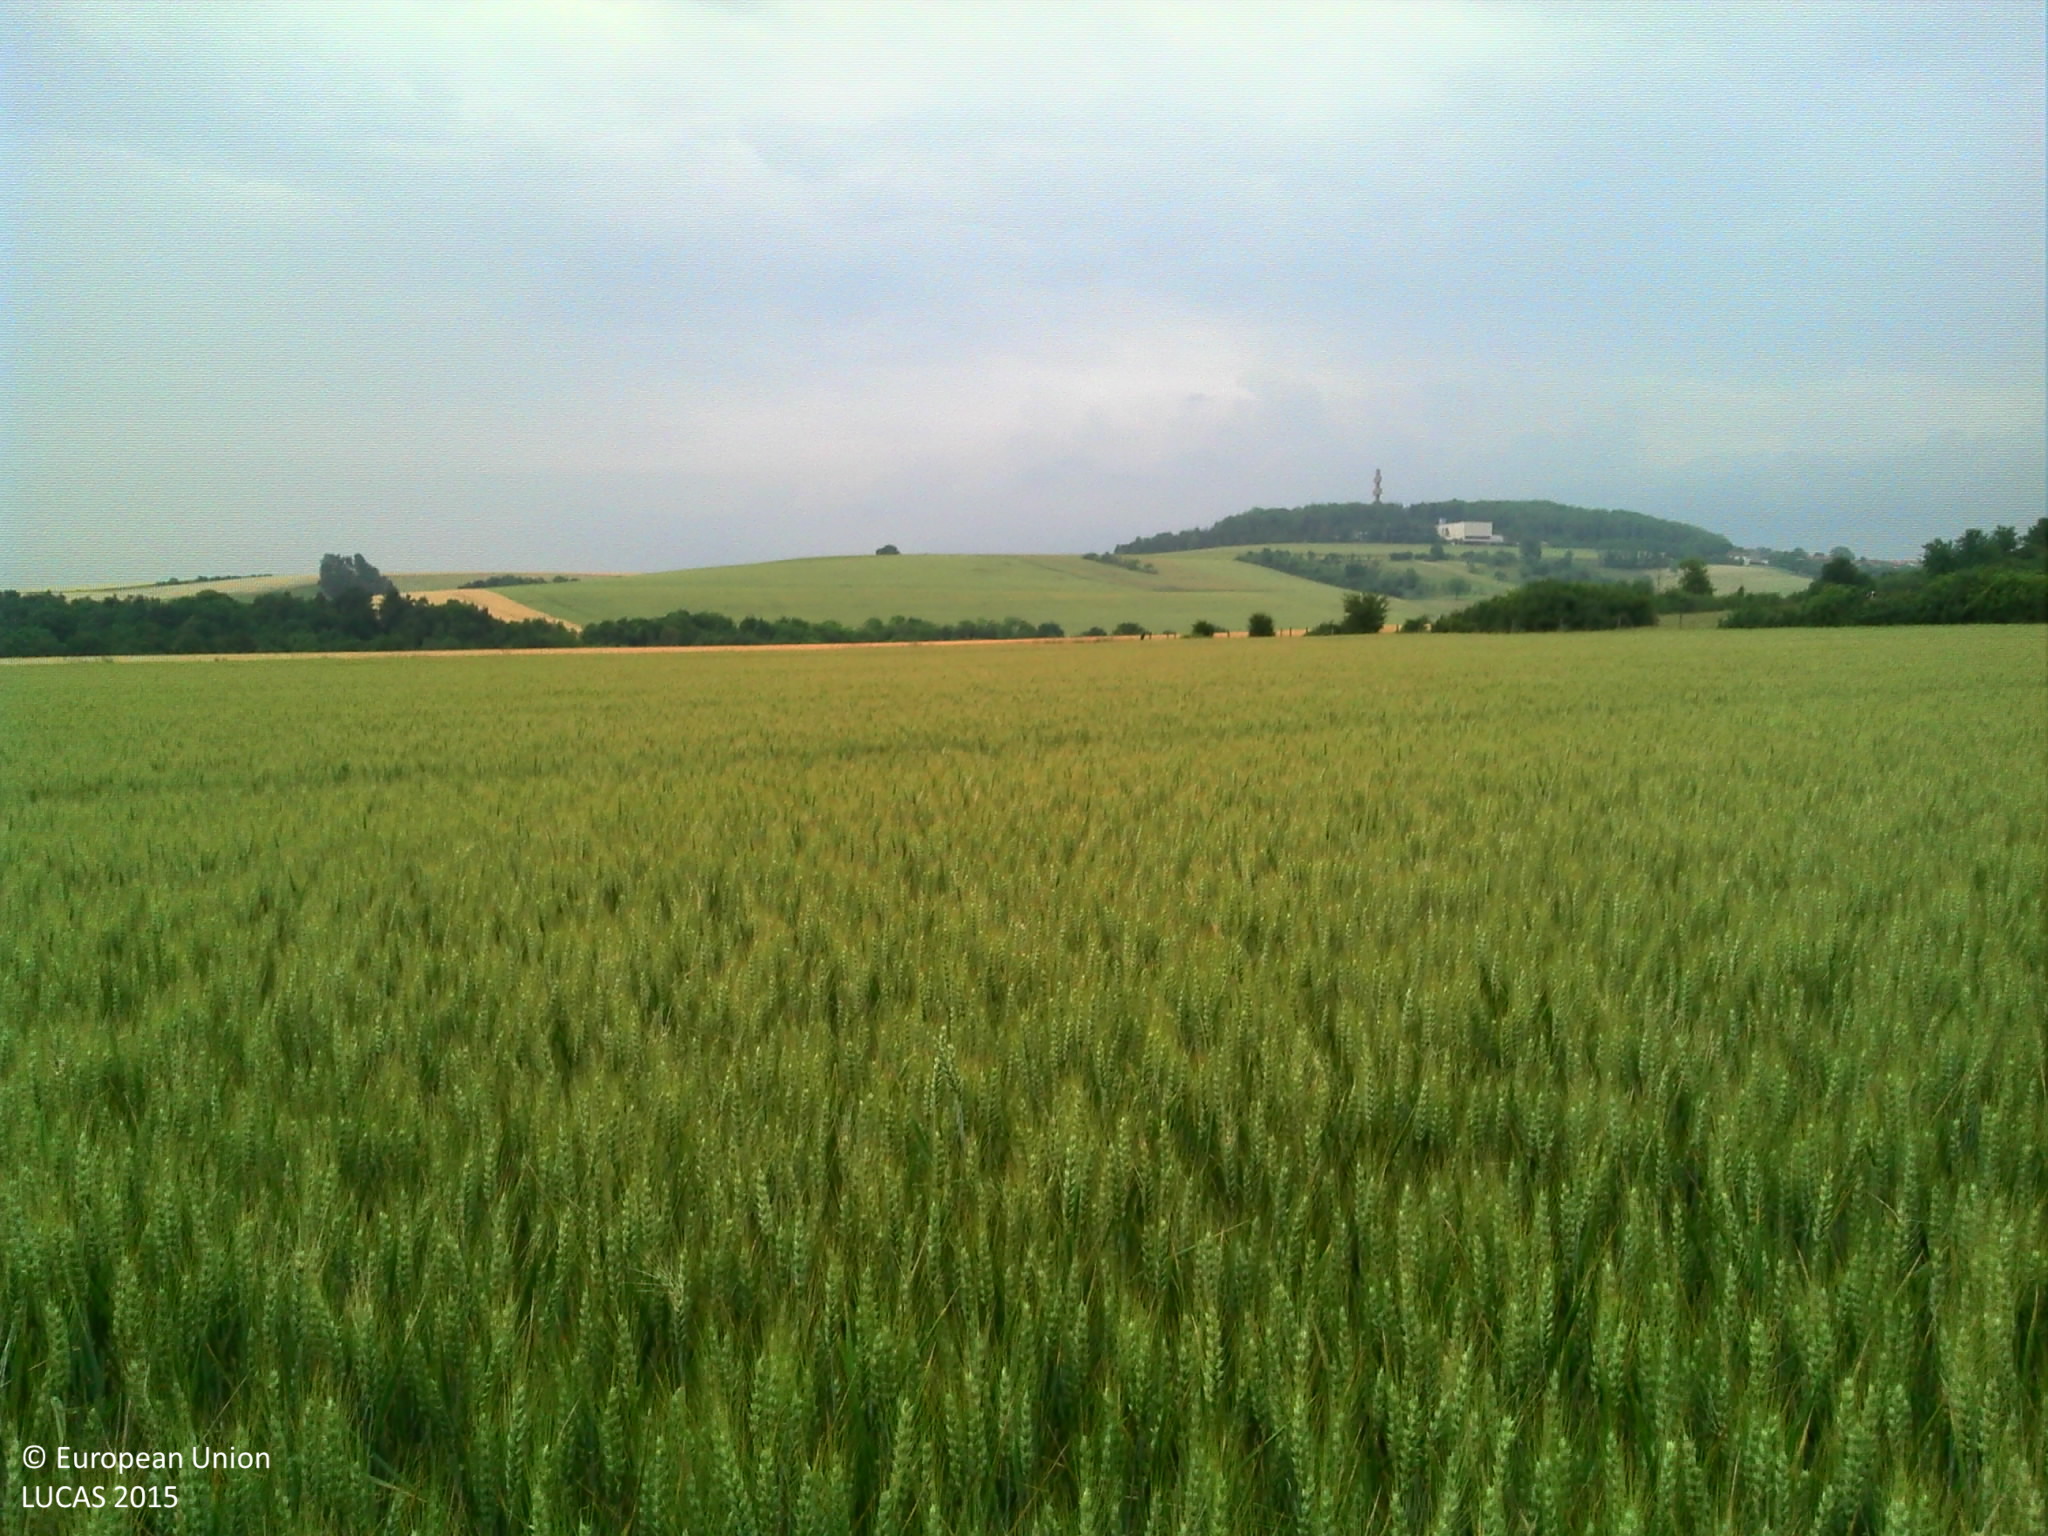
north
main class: Cropland
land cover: Common wheat
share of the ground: > 75 %
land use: Agriculture (excluding fallow land and kitchen gardens)
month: June
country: FR
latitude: 48.2124
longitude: 4.8711
